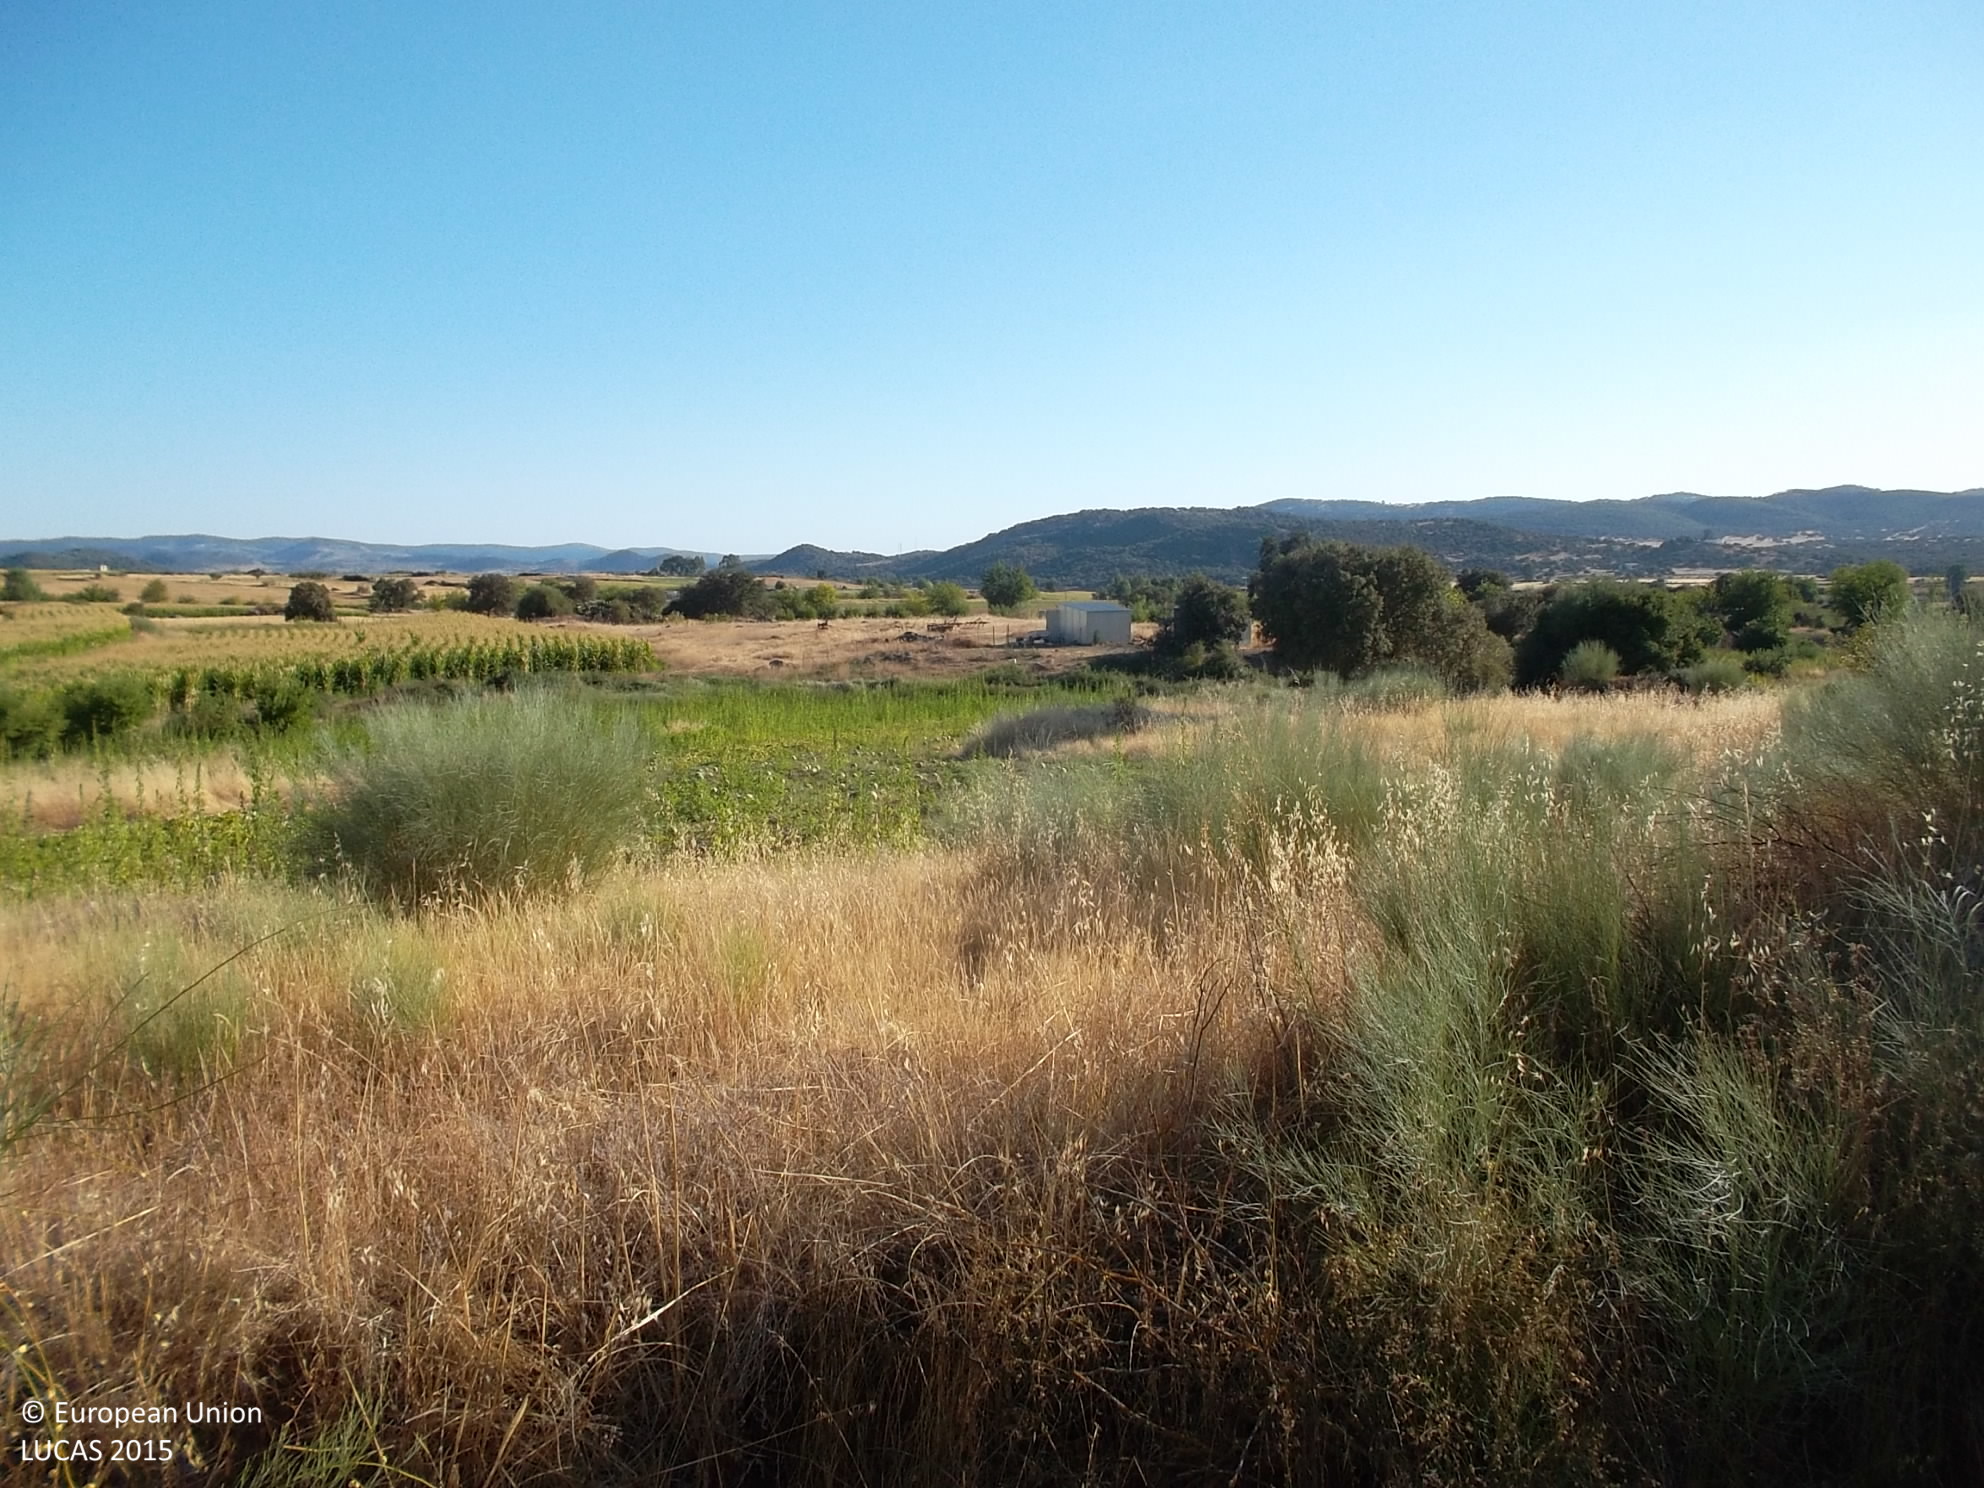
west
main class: Shrubland
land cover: Shrubland with sparse tree cover
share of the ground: > 75 %
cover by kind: herbaceous plants 75 %, shrubs 20 %, broadleaved forest trees 5 %
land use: Agriculture (excluding fallow land and kitchen gardens)
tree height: < 5 m
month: August
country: ES
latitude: 38.3663
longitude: -6.6844
